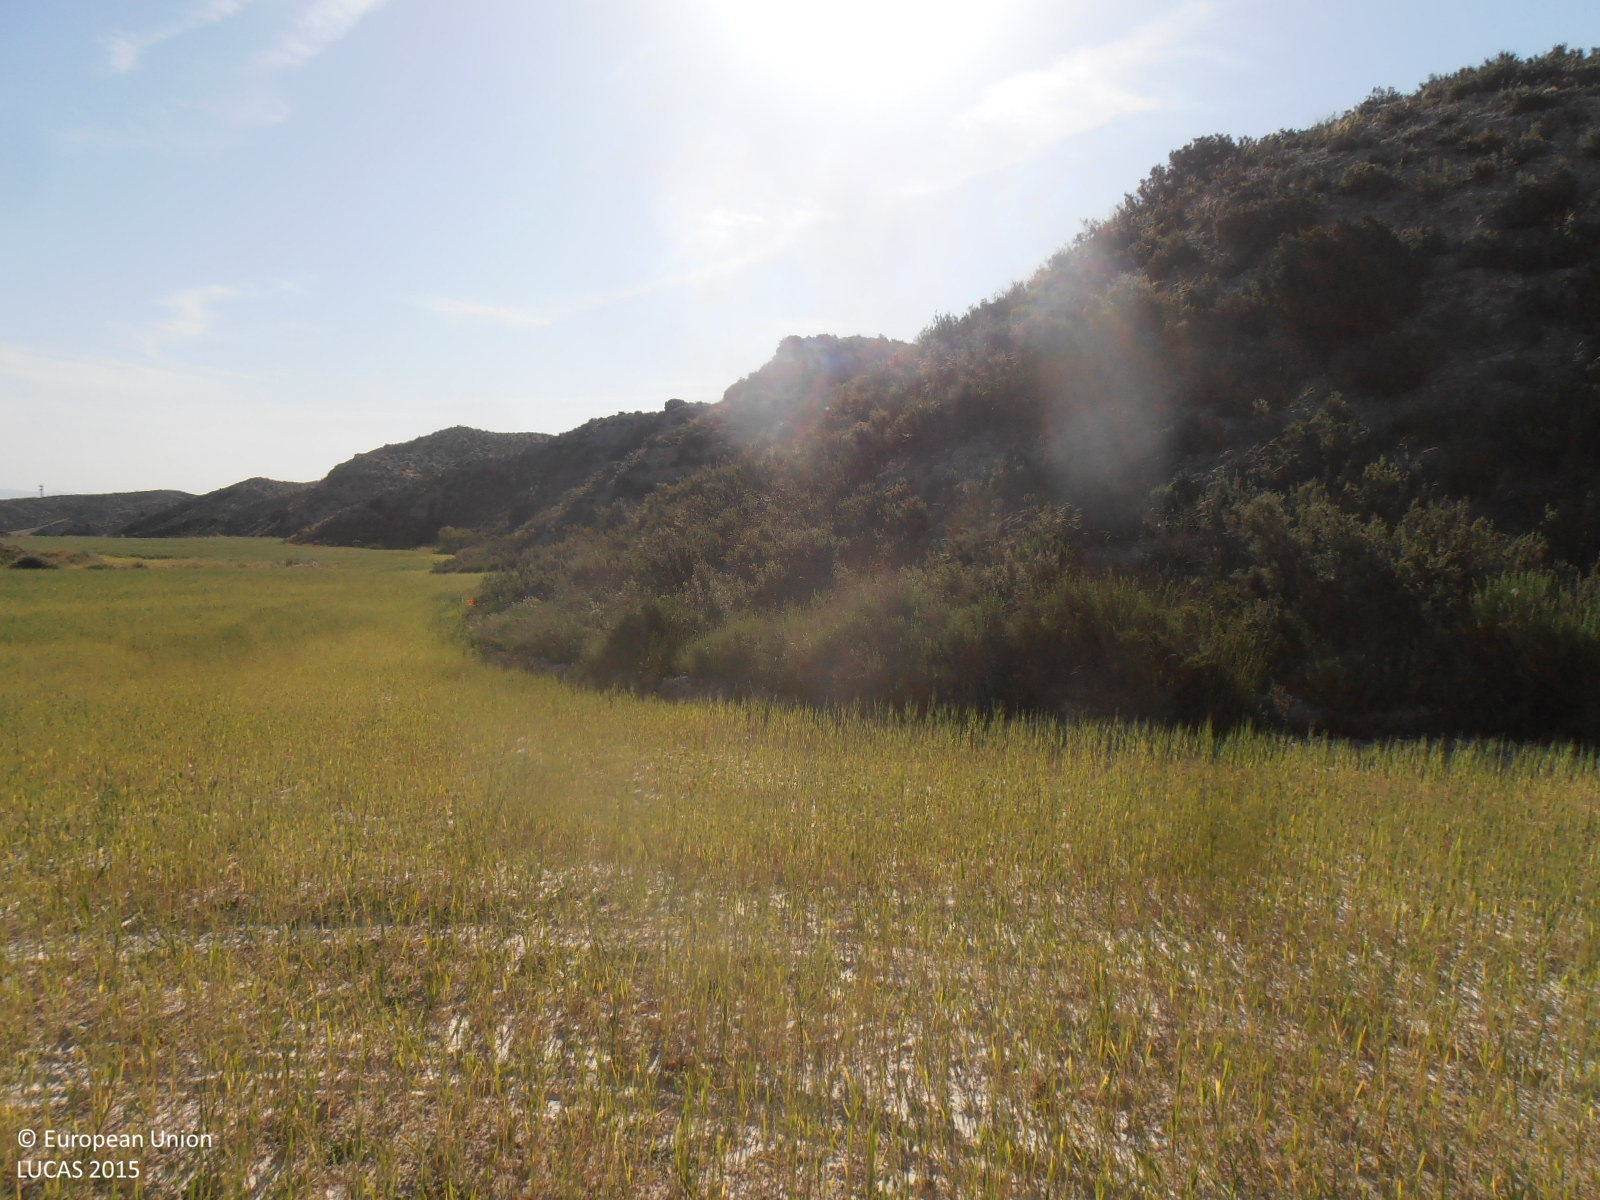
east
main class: Cropland
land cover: Durum wheat
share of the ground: > 75 %
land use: Agriculture (excluding fallow land and kitchen gardens)
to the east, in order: Durum wheat; Shrubland without tree cover; Durum wheat; Shrubland without tree cover; Durum wheat
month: May
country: ES
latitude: 41.5496
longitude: -0.7738
